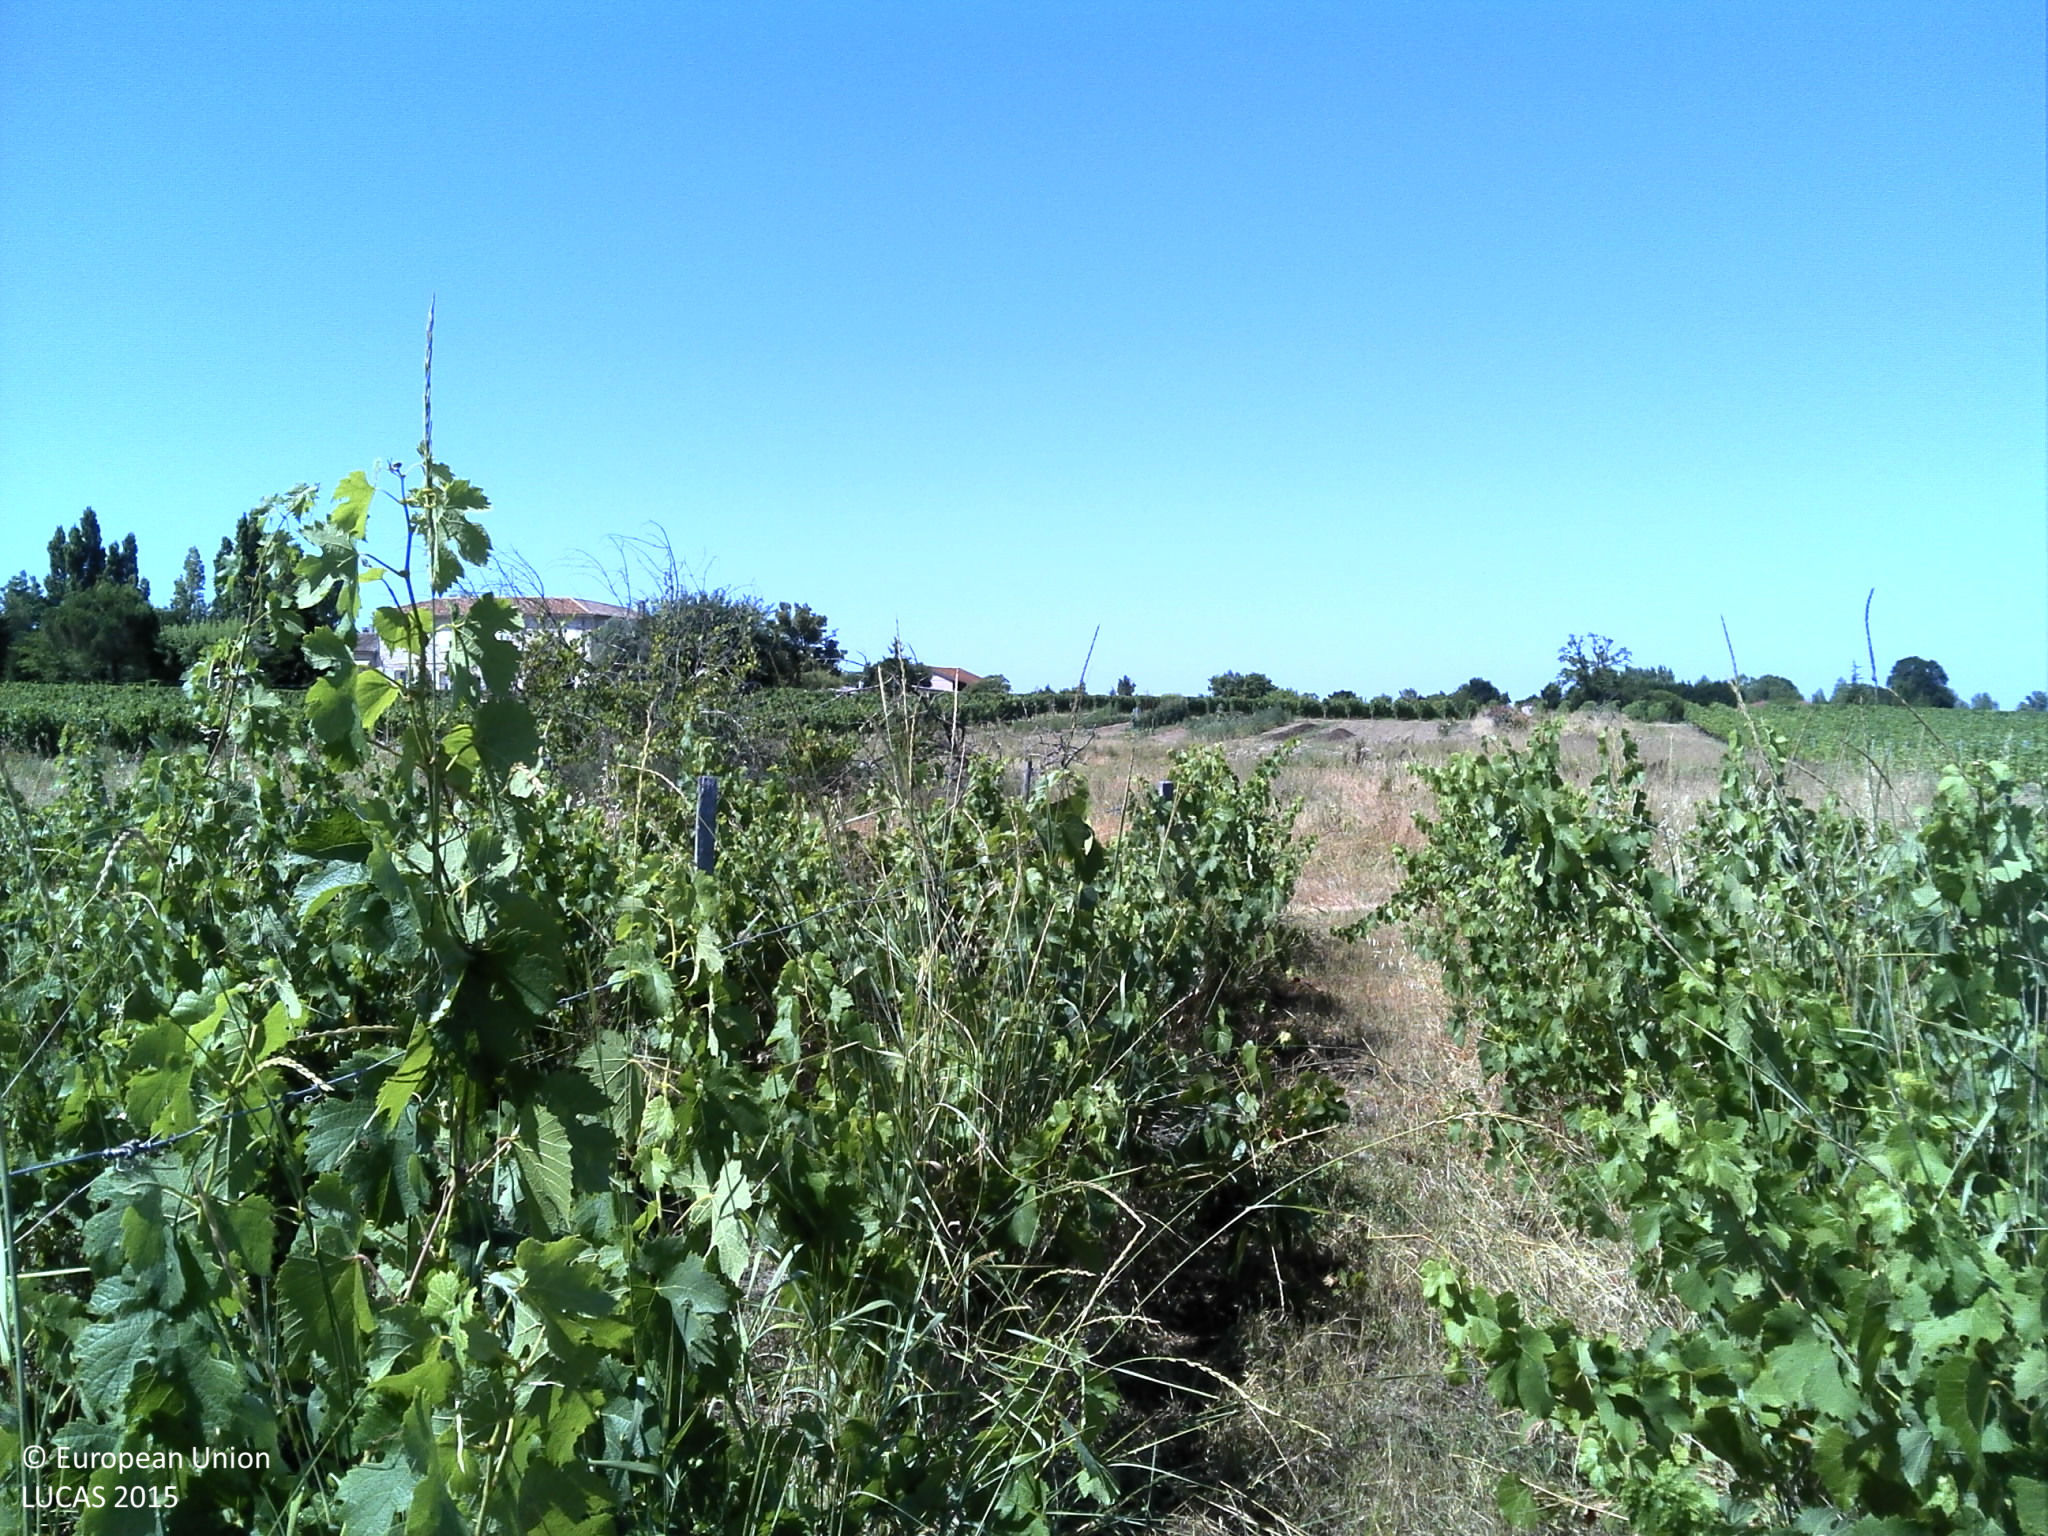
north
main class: Cropland
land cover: Vineyards
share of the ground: 10 - 25 %
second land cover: Grassland without tree/shrub cover
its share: > 75 %
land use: Agriculture (excluding fallow land and kitchen gardens)
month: July
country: FR
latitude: 44.8947
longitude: -0.4390
